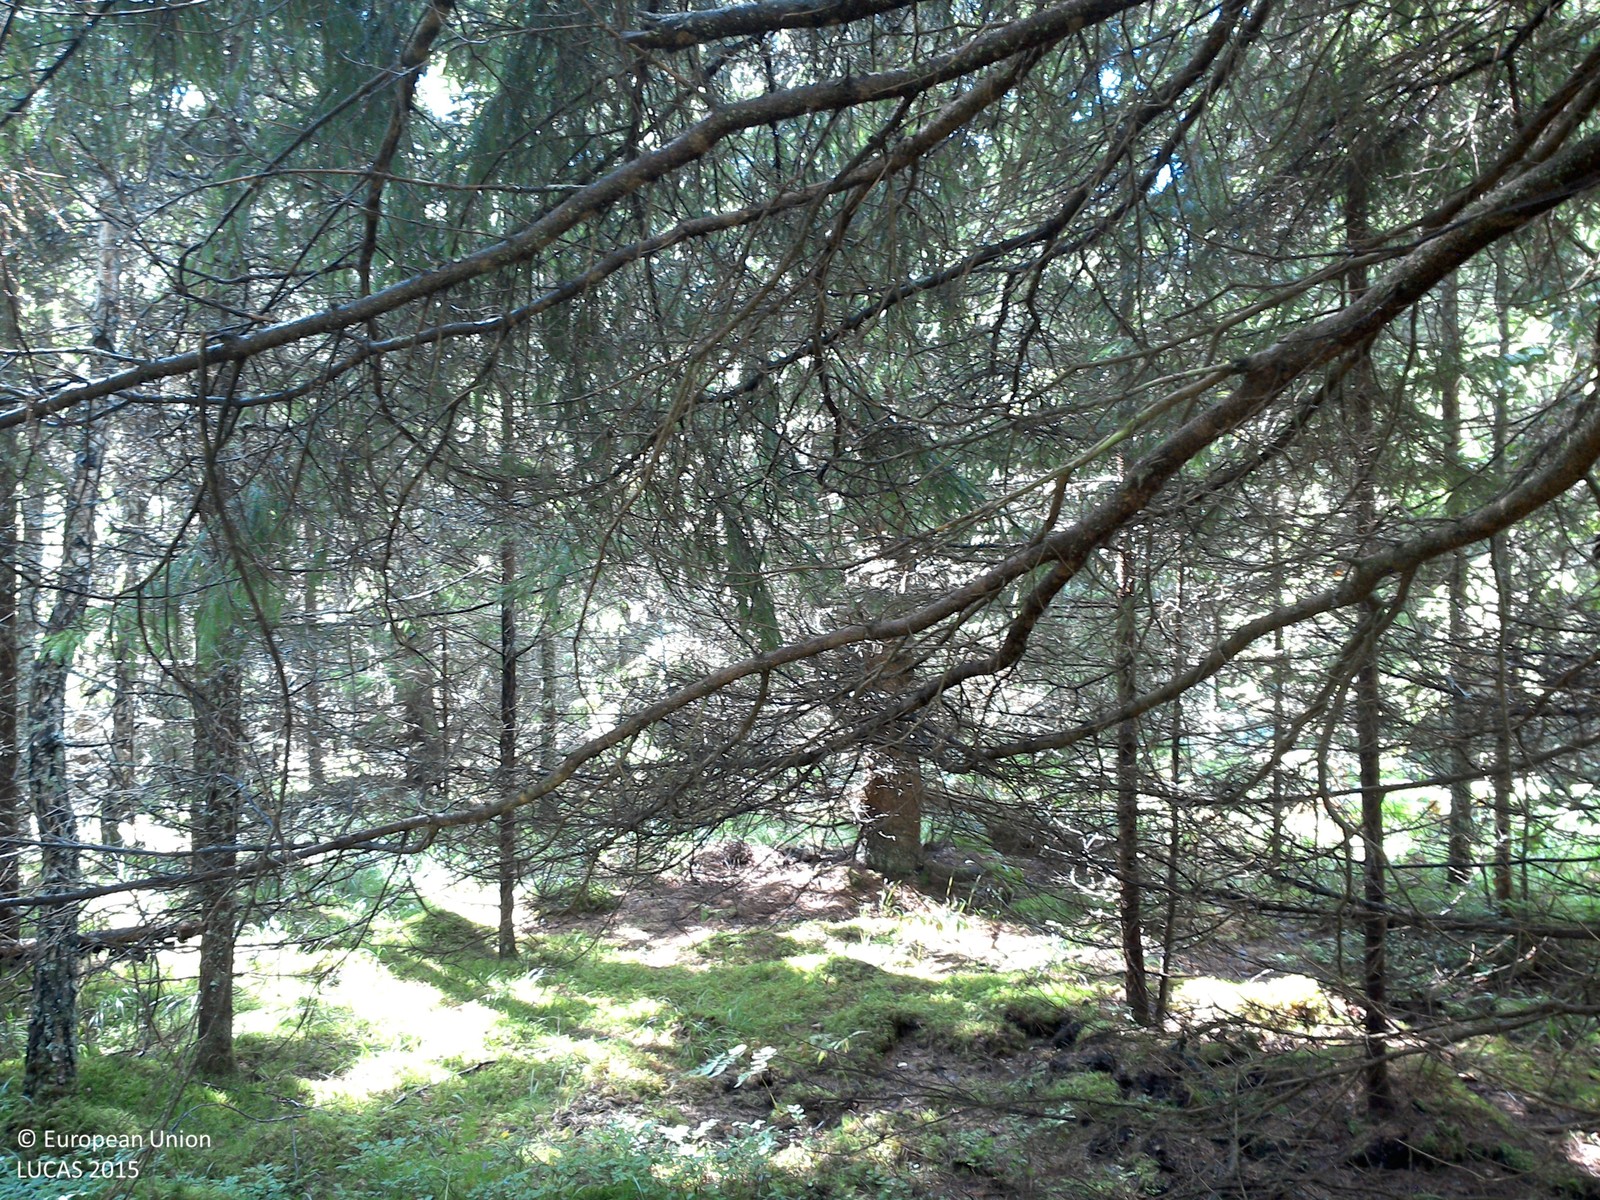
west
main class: Woodland
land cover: Spruce dominated coniferous woodland
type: boreal forest
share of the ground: 50 - 75 %
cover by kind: coniferous forest trees 60 %, lichens and mosses 30 %, herbaceous plants 10 %
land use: Forestry
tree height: > 5 m
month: August
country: SE
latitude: 58.1838
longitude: 15.3859
